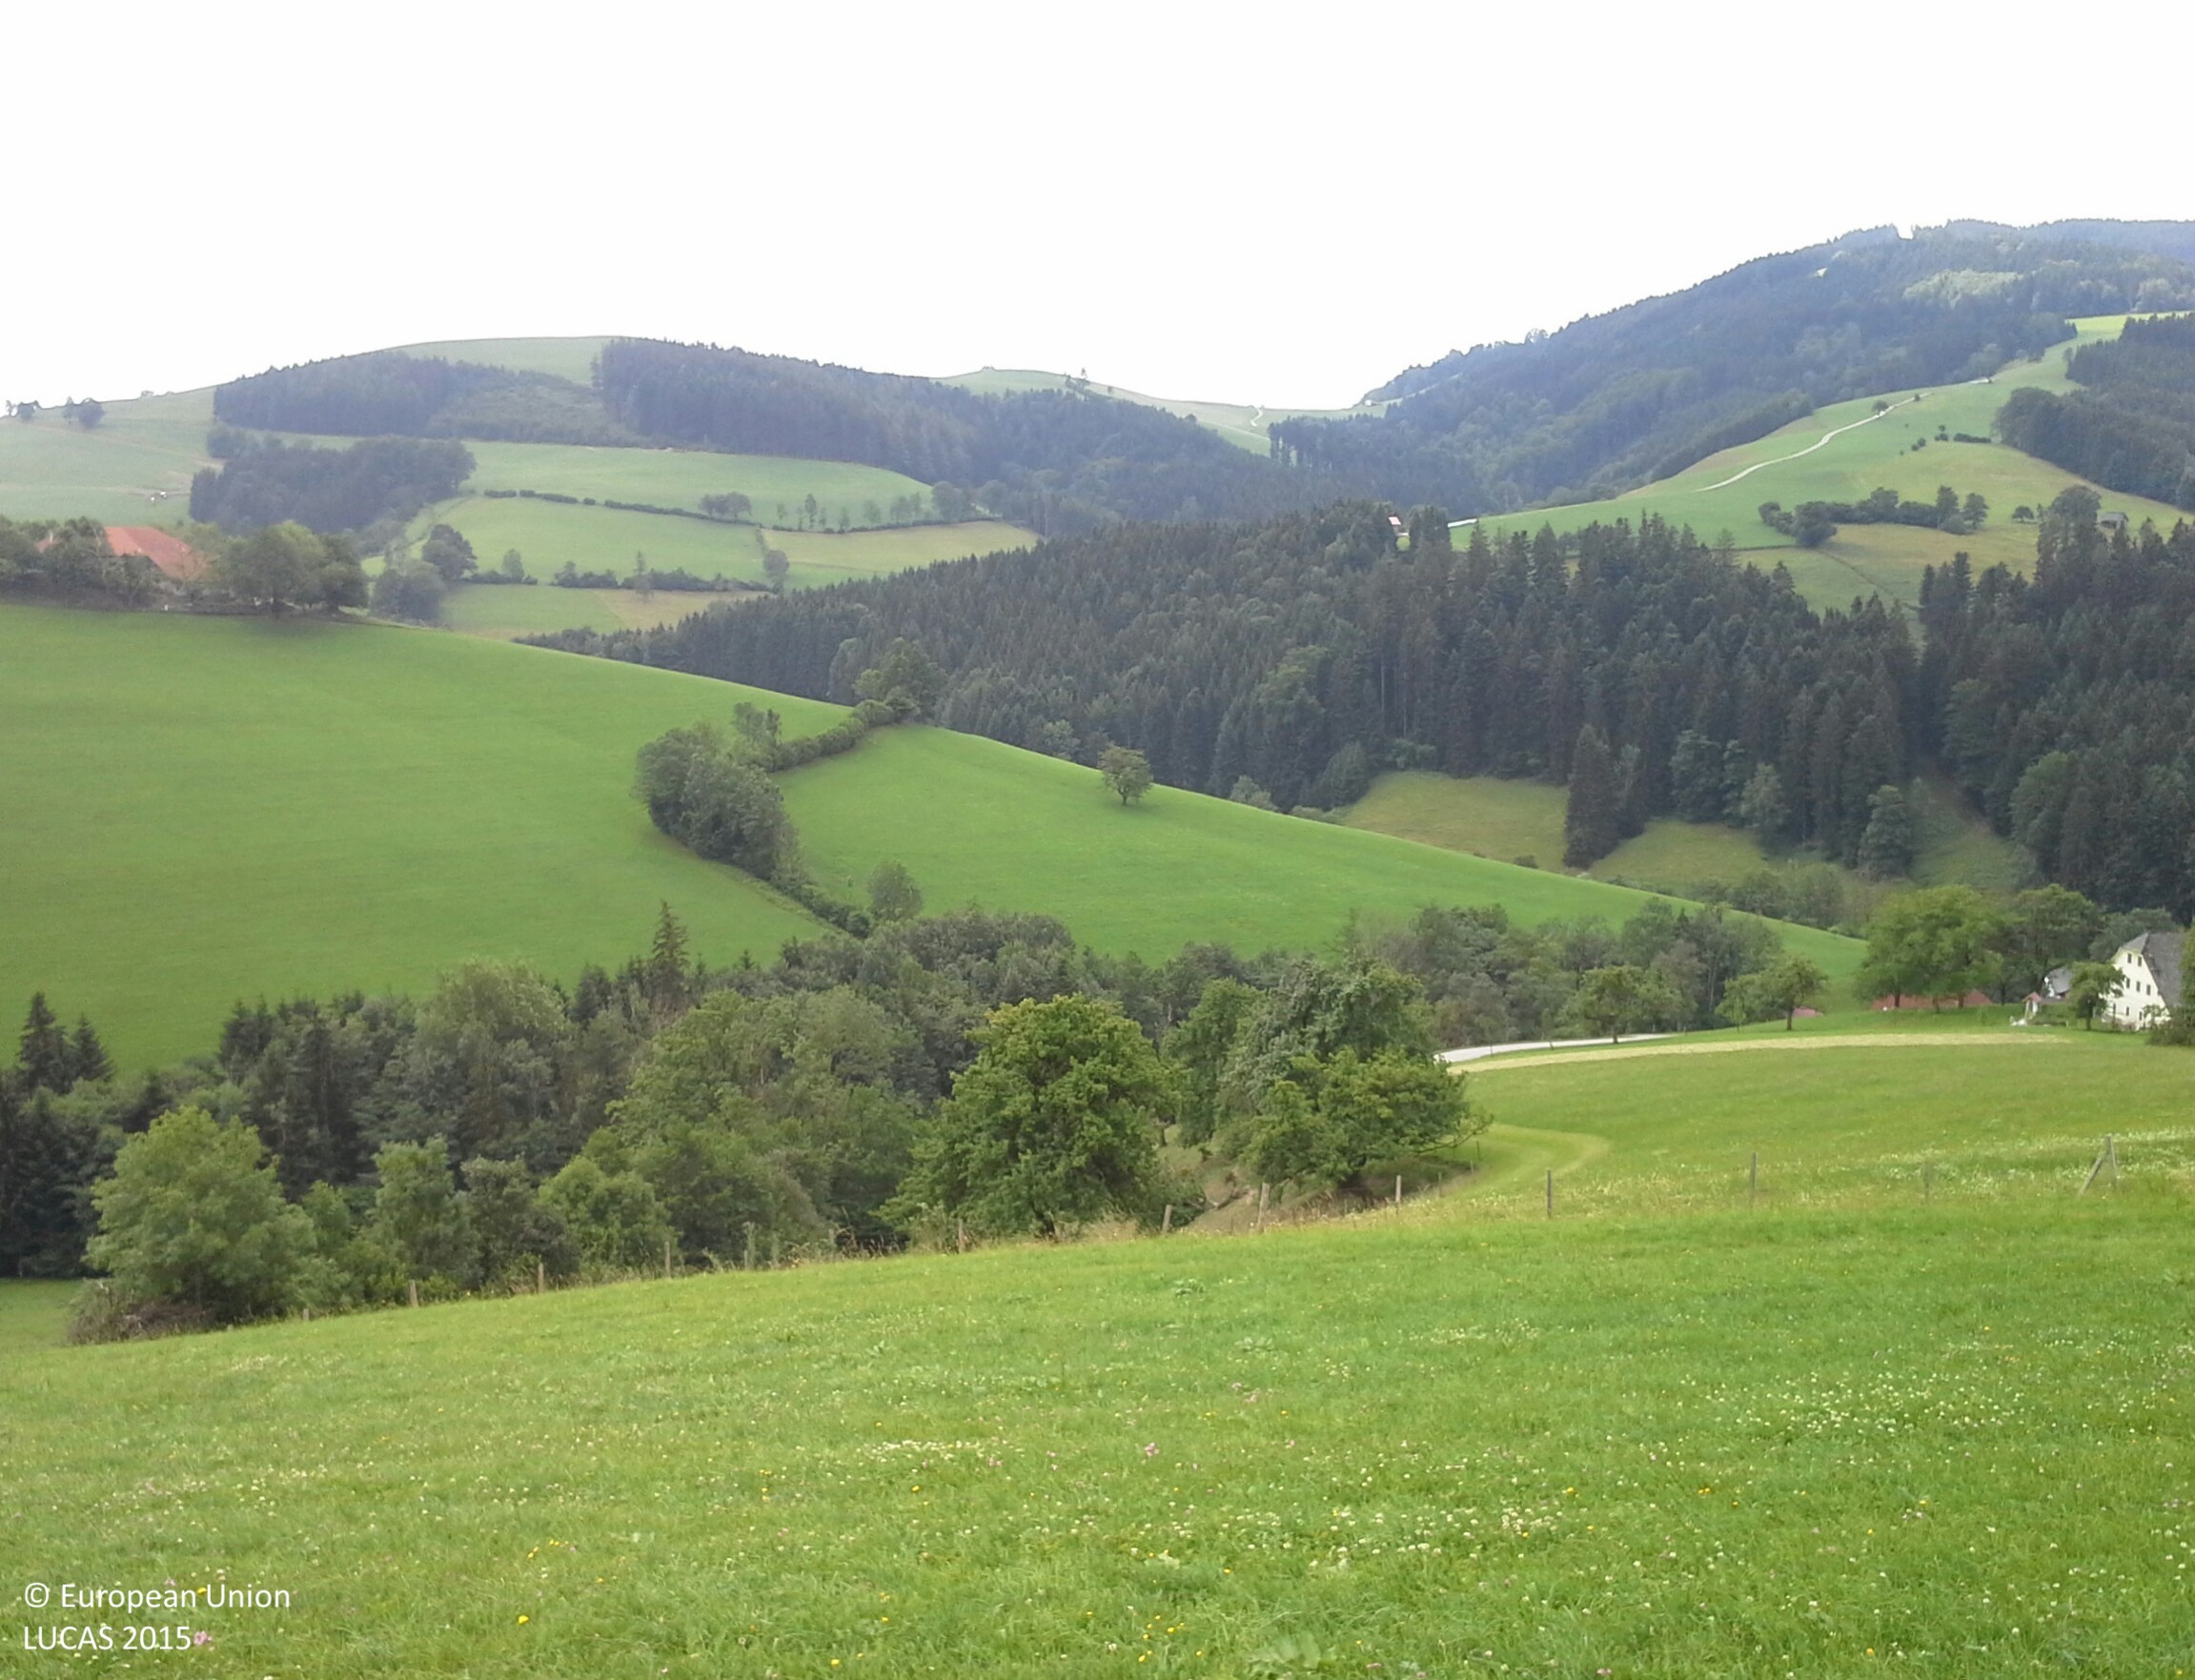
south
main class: Grassland
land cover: Grassland without tree/shrub cover
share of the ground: > 75 %
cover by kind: herbaceous plants 100 %
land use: Agriculture (excluding fallow land and kitchen gardens)
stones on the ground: > 50 %
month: July
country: AT
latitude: 47.9656
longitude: 14.5941
